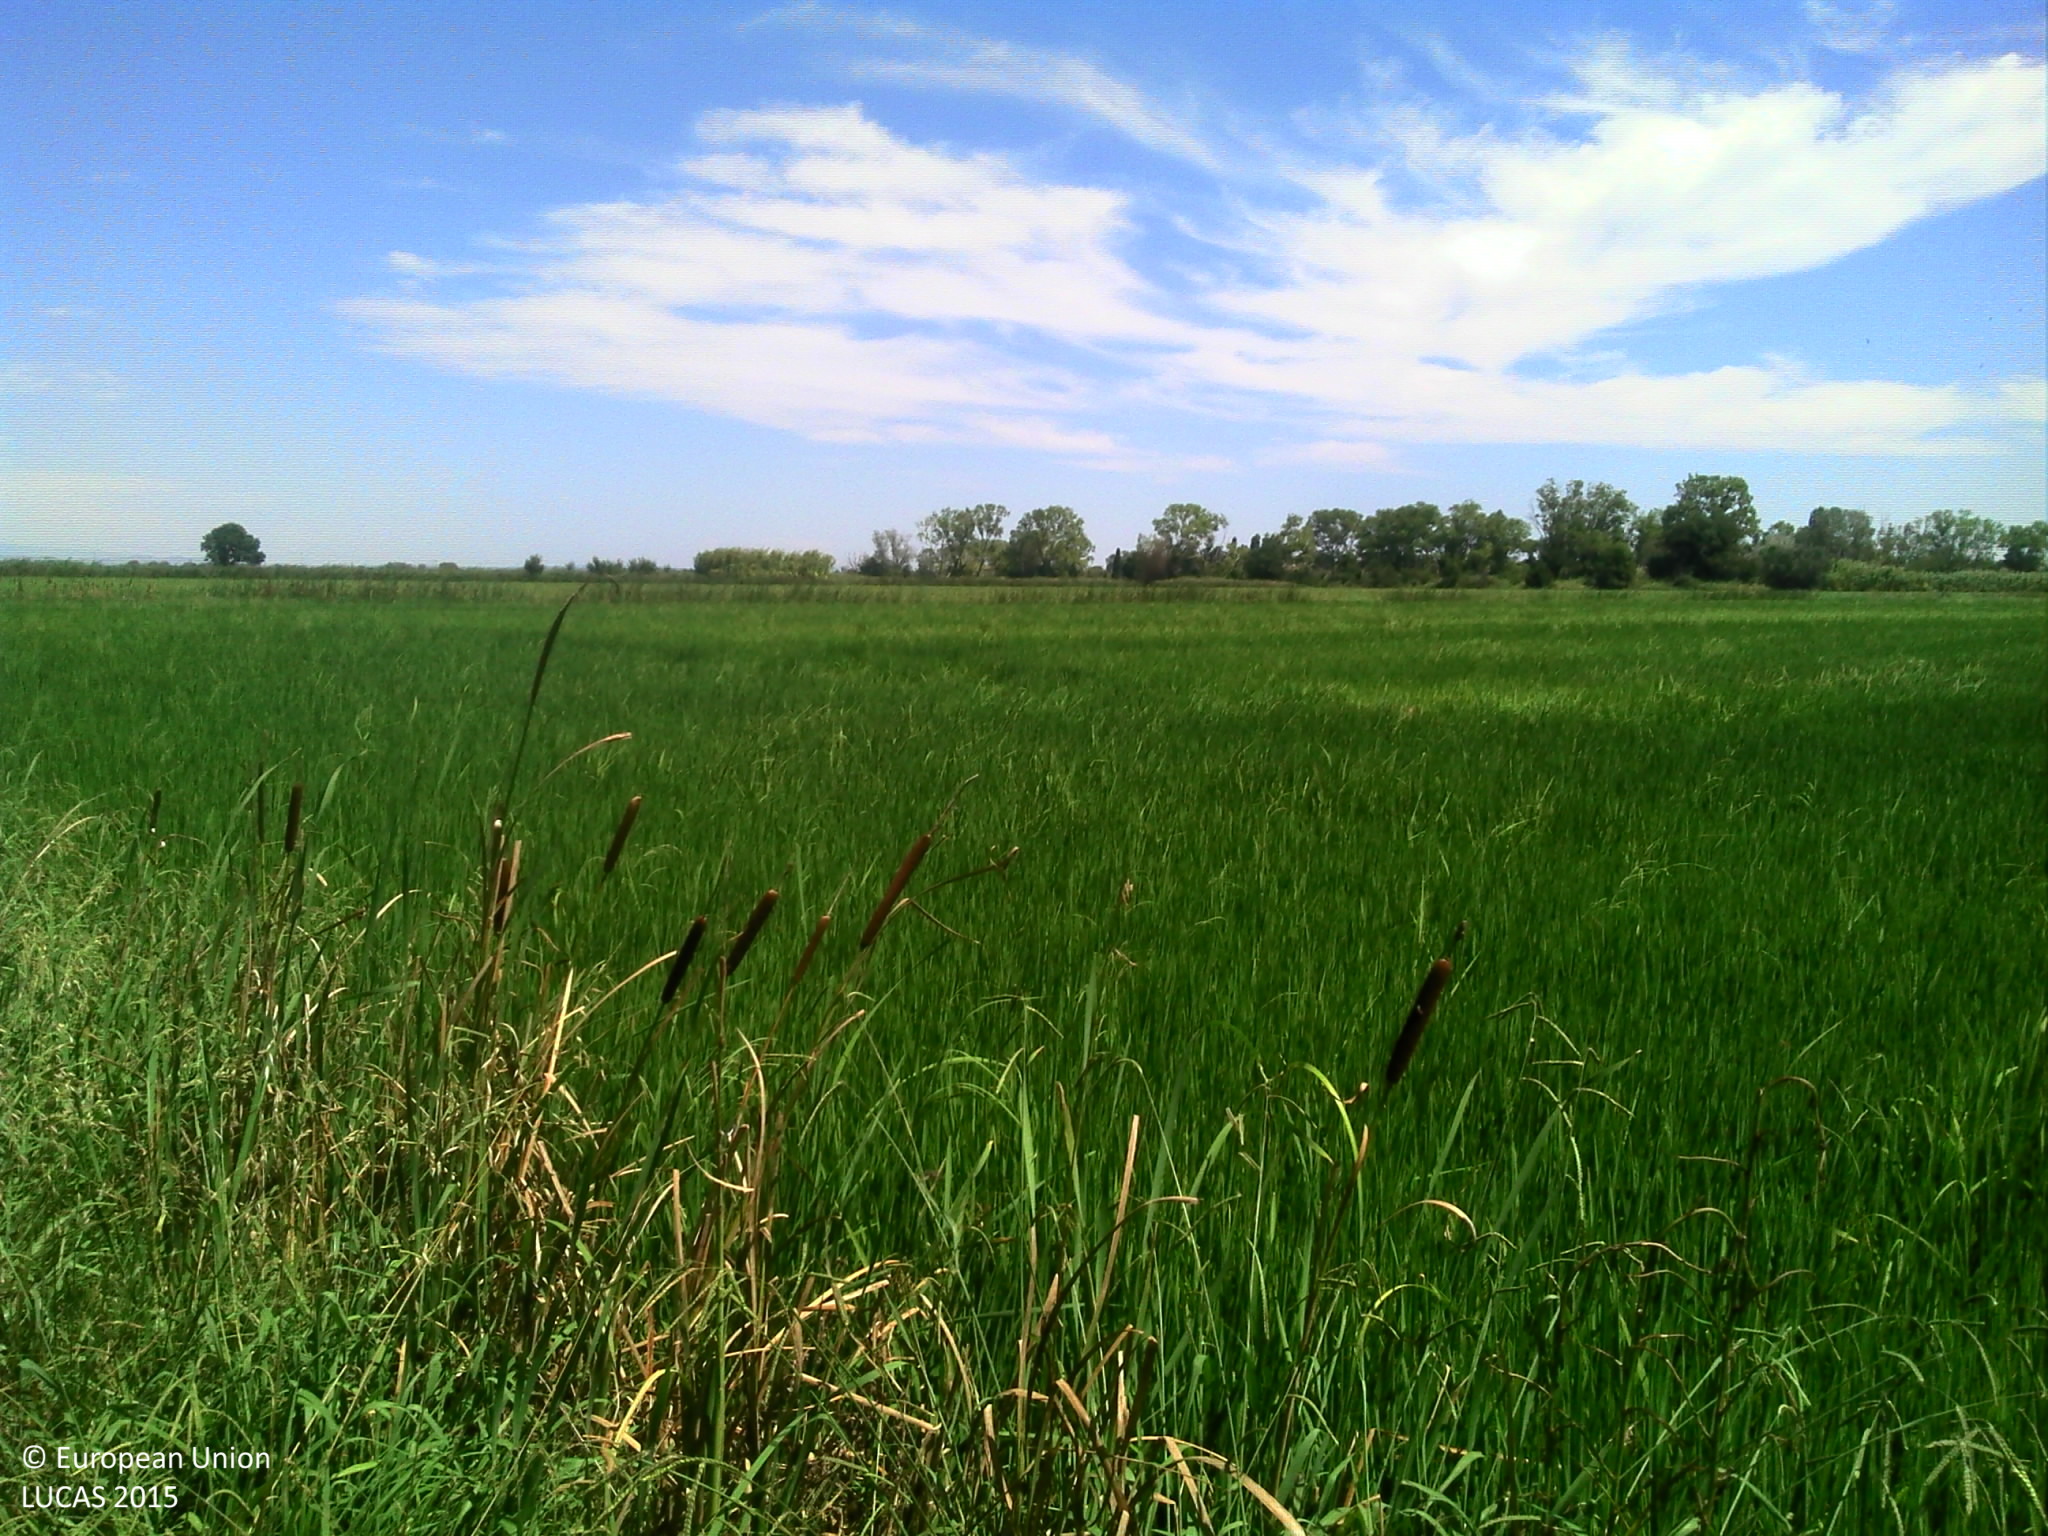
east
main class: Cropland
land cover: Rice
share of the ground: > 75 %
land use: Agriculture (excluding fallow land and kitchen gardens)
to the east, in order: Rice; Grass margins; Tracks; Grass margins; Rice
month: July
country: FR
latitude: 43.4768
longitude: 4.7559
